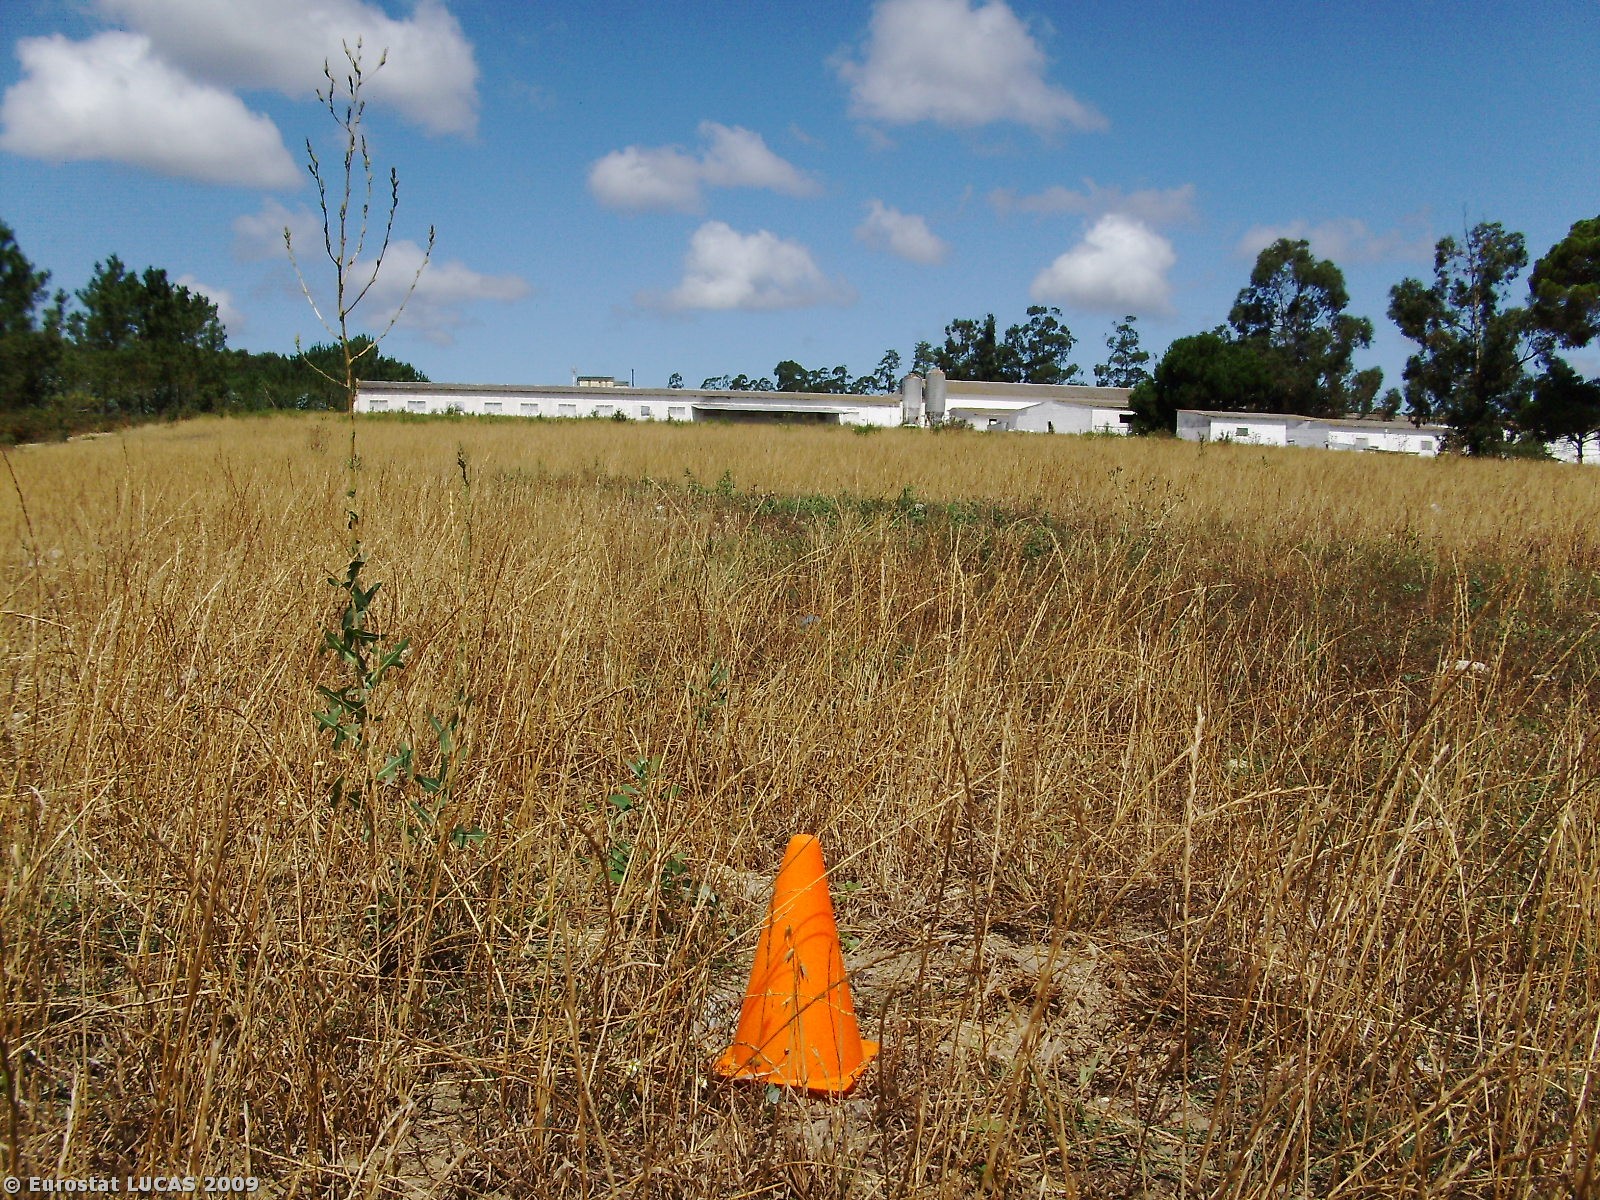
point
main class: Grassland
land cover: Spontaneously vegetated surfaces
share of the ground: > 75 %
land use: Fallow land
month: July
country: PT
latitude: 39.7688
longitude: -8.8717
